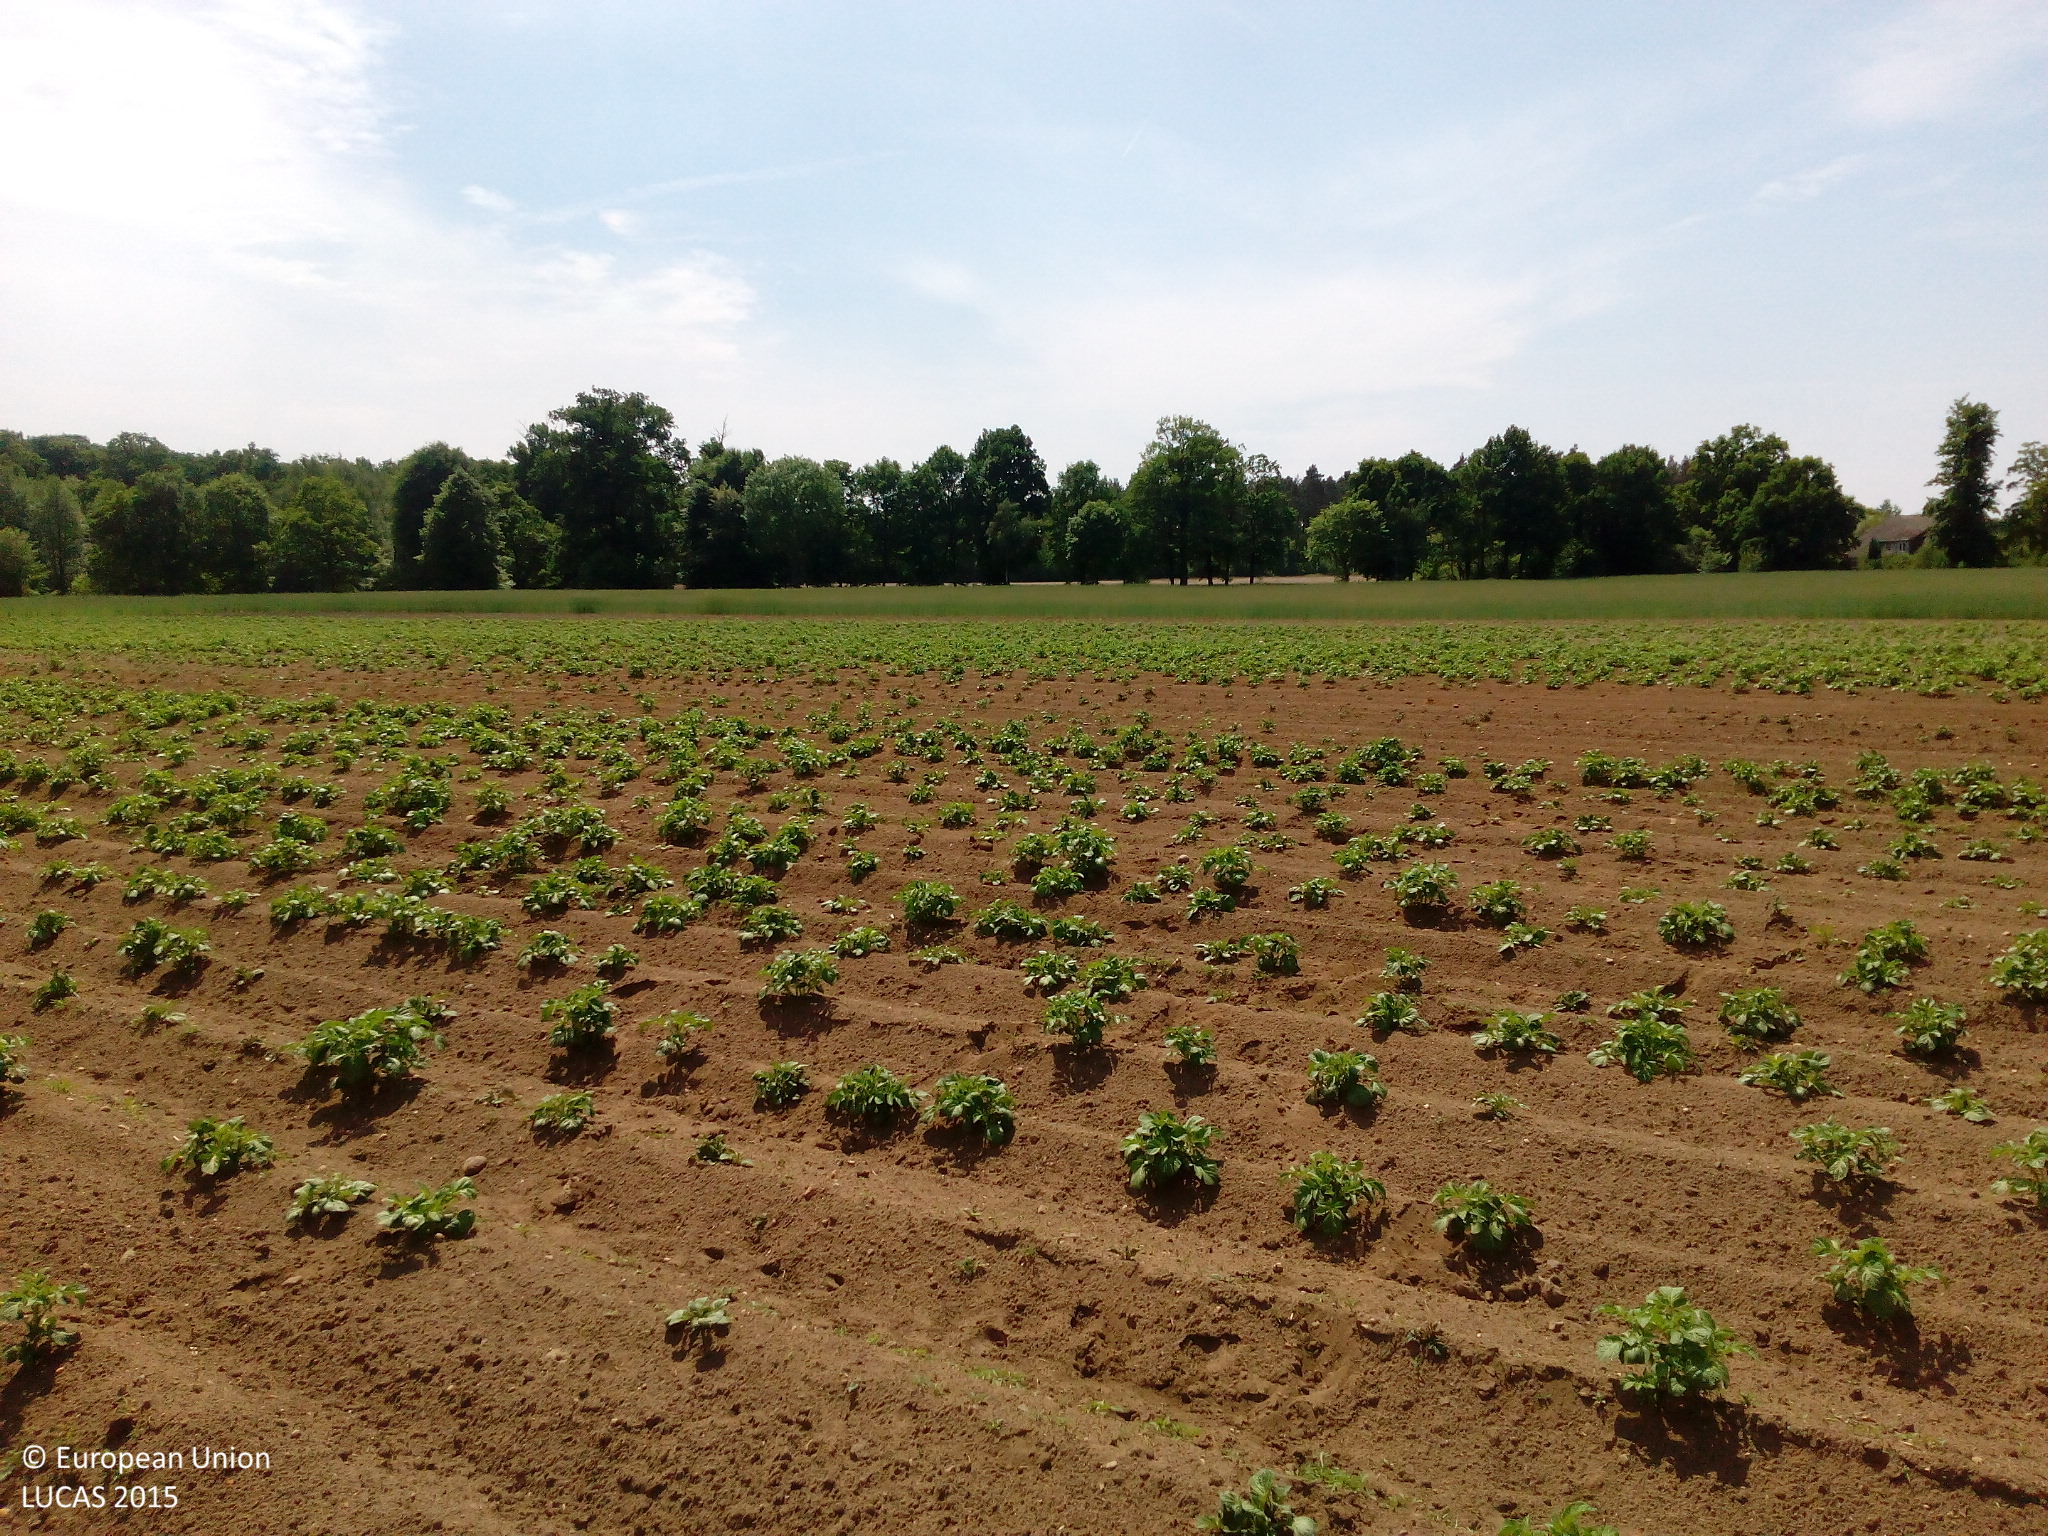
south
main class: Cropland
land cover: Rye
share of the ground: > 75 %
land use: Agriculture (excluding fallow land and kitchen gardens)
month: May
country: DE
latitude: 51.6790
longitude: 14.0360
